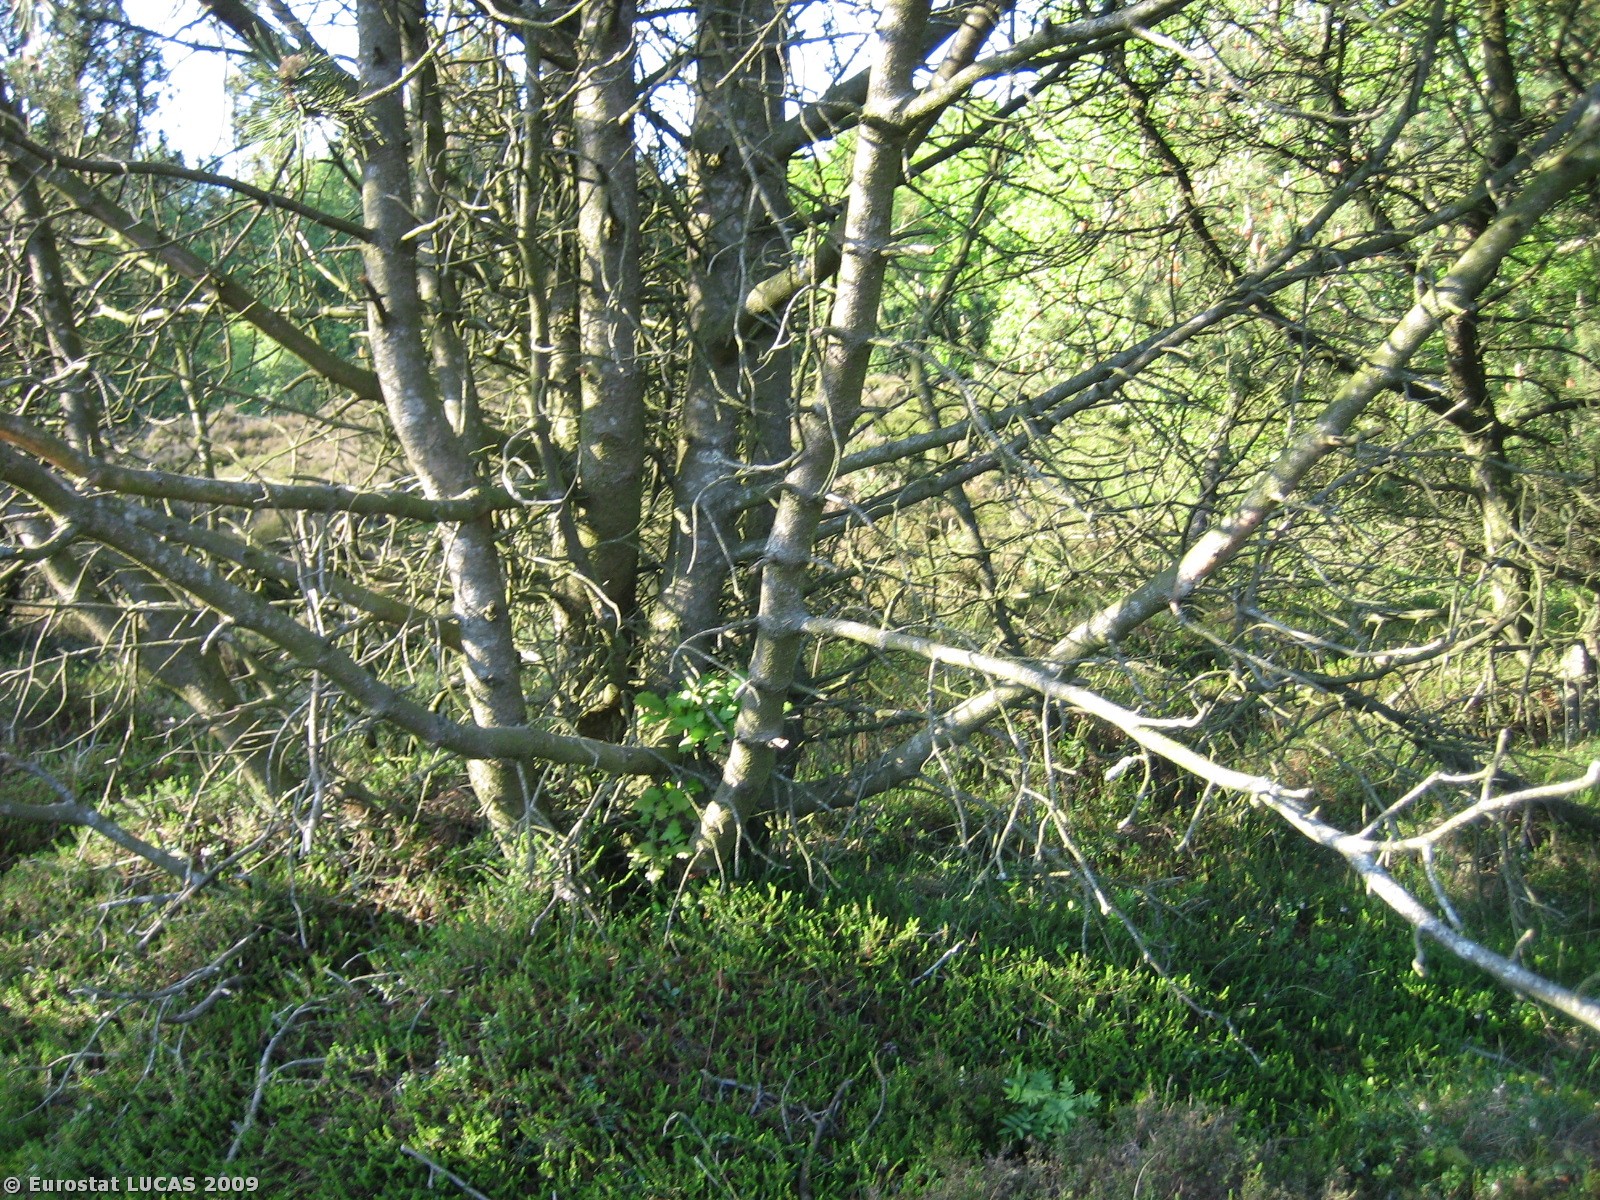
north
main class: Shrubland
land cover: Shrubland with sparse tree cover
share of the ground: > 75 %
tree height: > 5 m
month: May
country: DK
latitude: 55.9696
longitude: 9.2158
